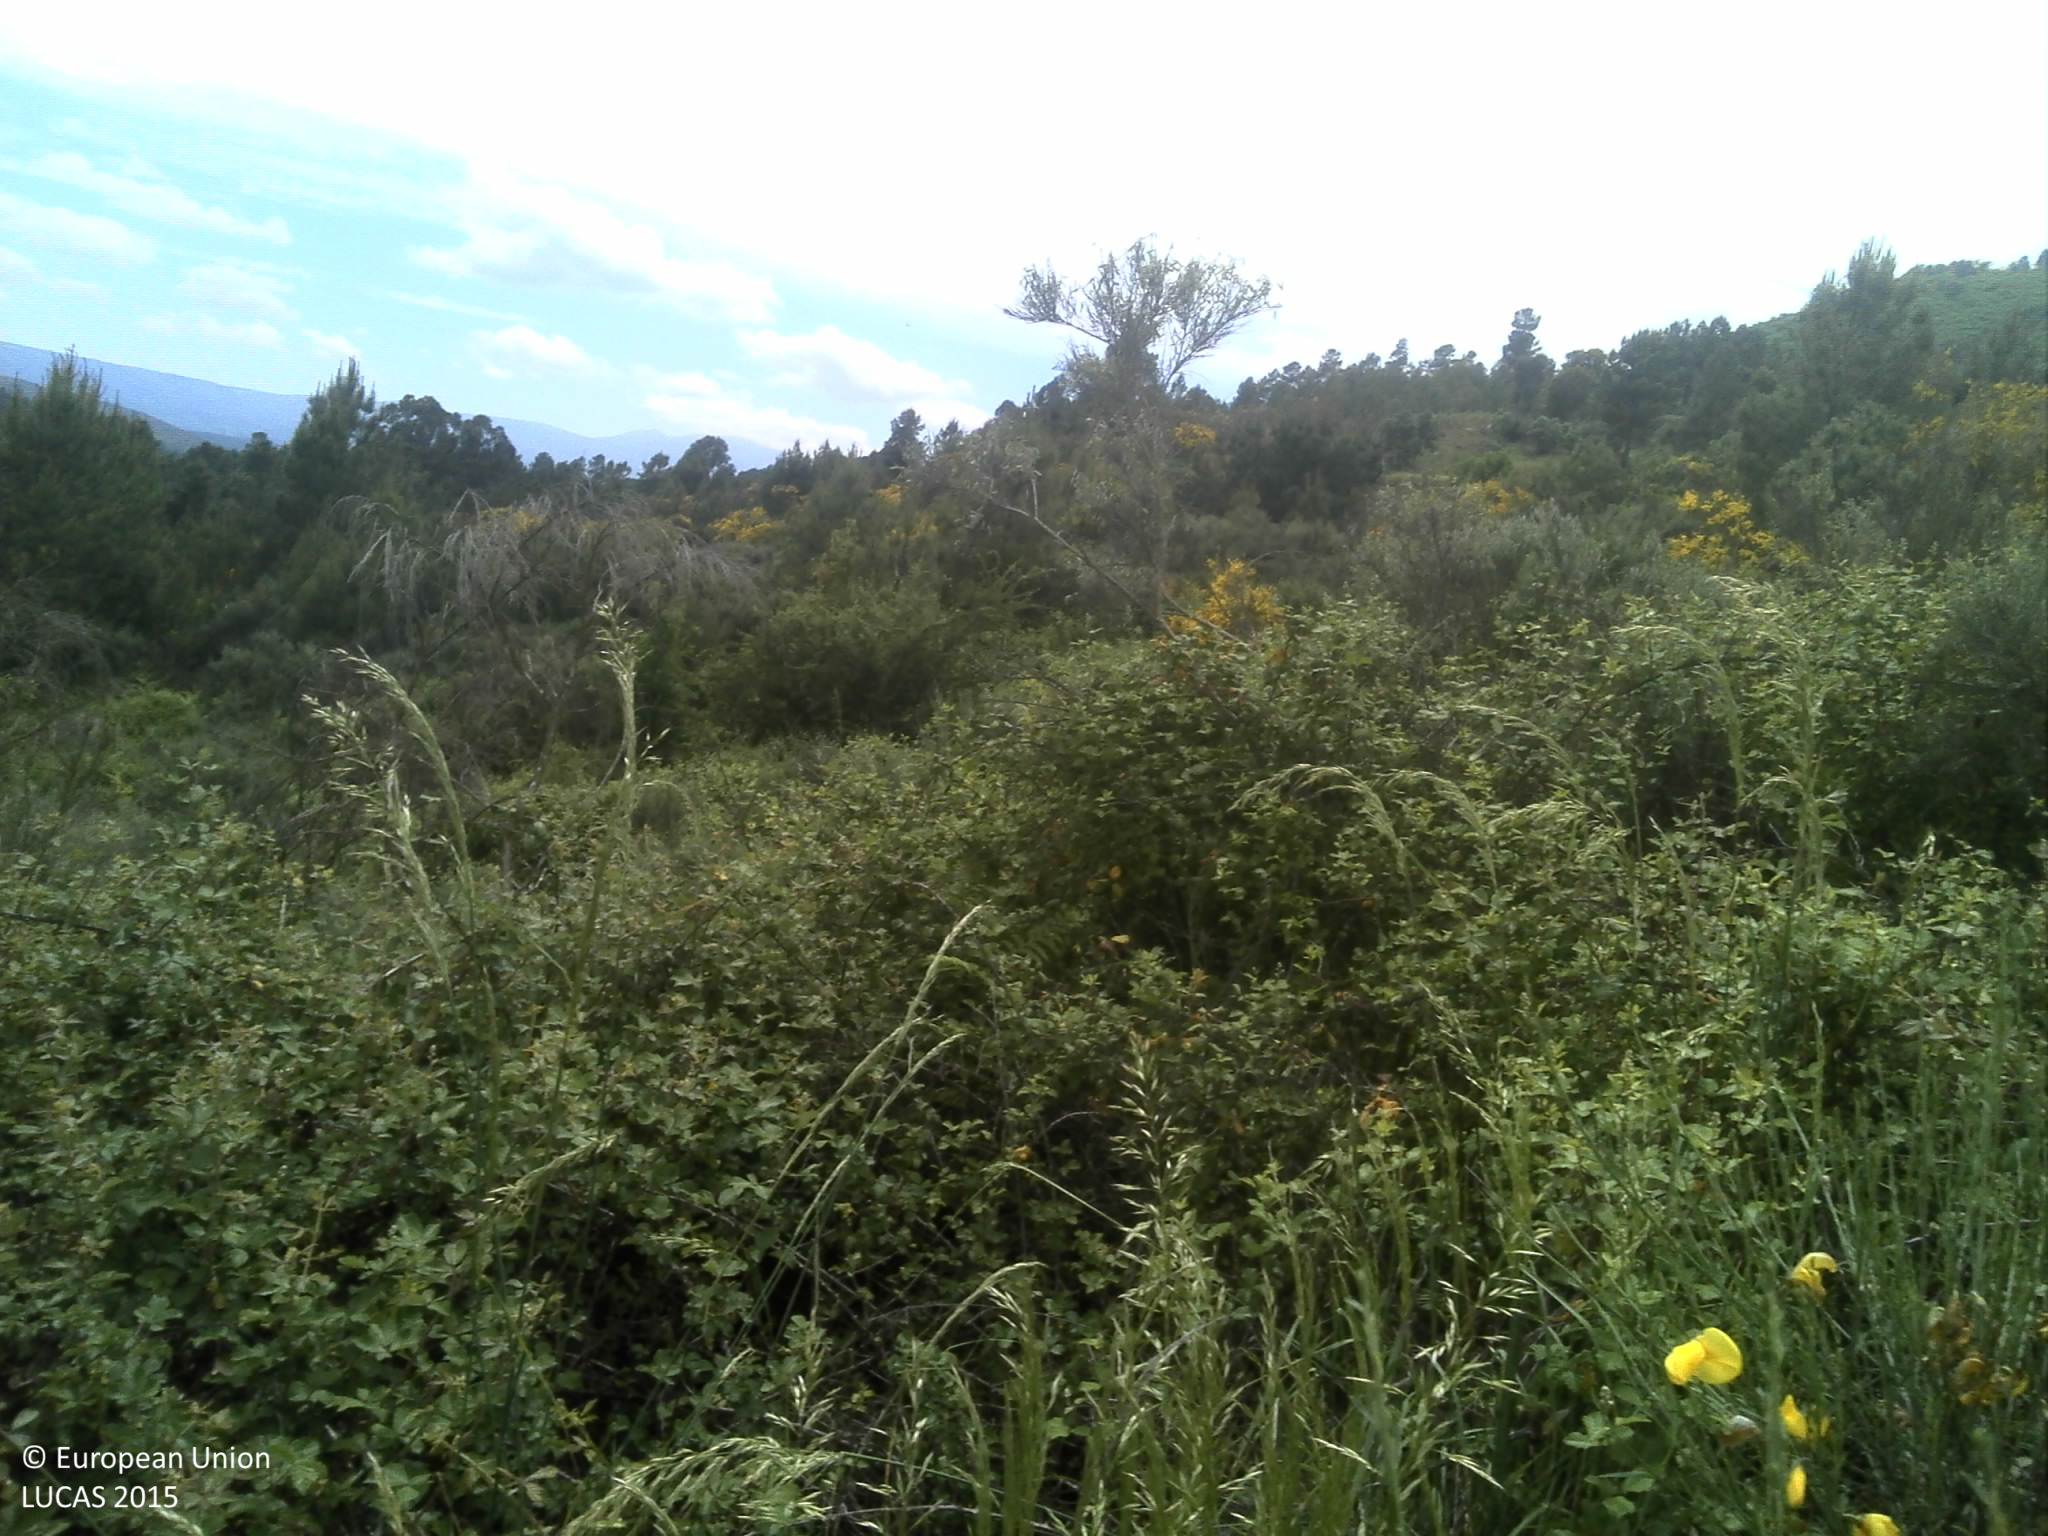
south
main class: Shrubland
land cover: Shrubland with sparse tree cover
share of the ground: > 75 %
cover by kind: shrubs 90 %, coniferous forest trees 5 %, unconsolidated bare surface 5 %
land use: Semi-natural and natural areas not in use
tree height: < 5 m
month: May
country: PT
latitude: 40.7009
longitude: -7.4516
